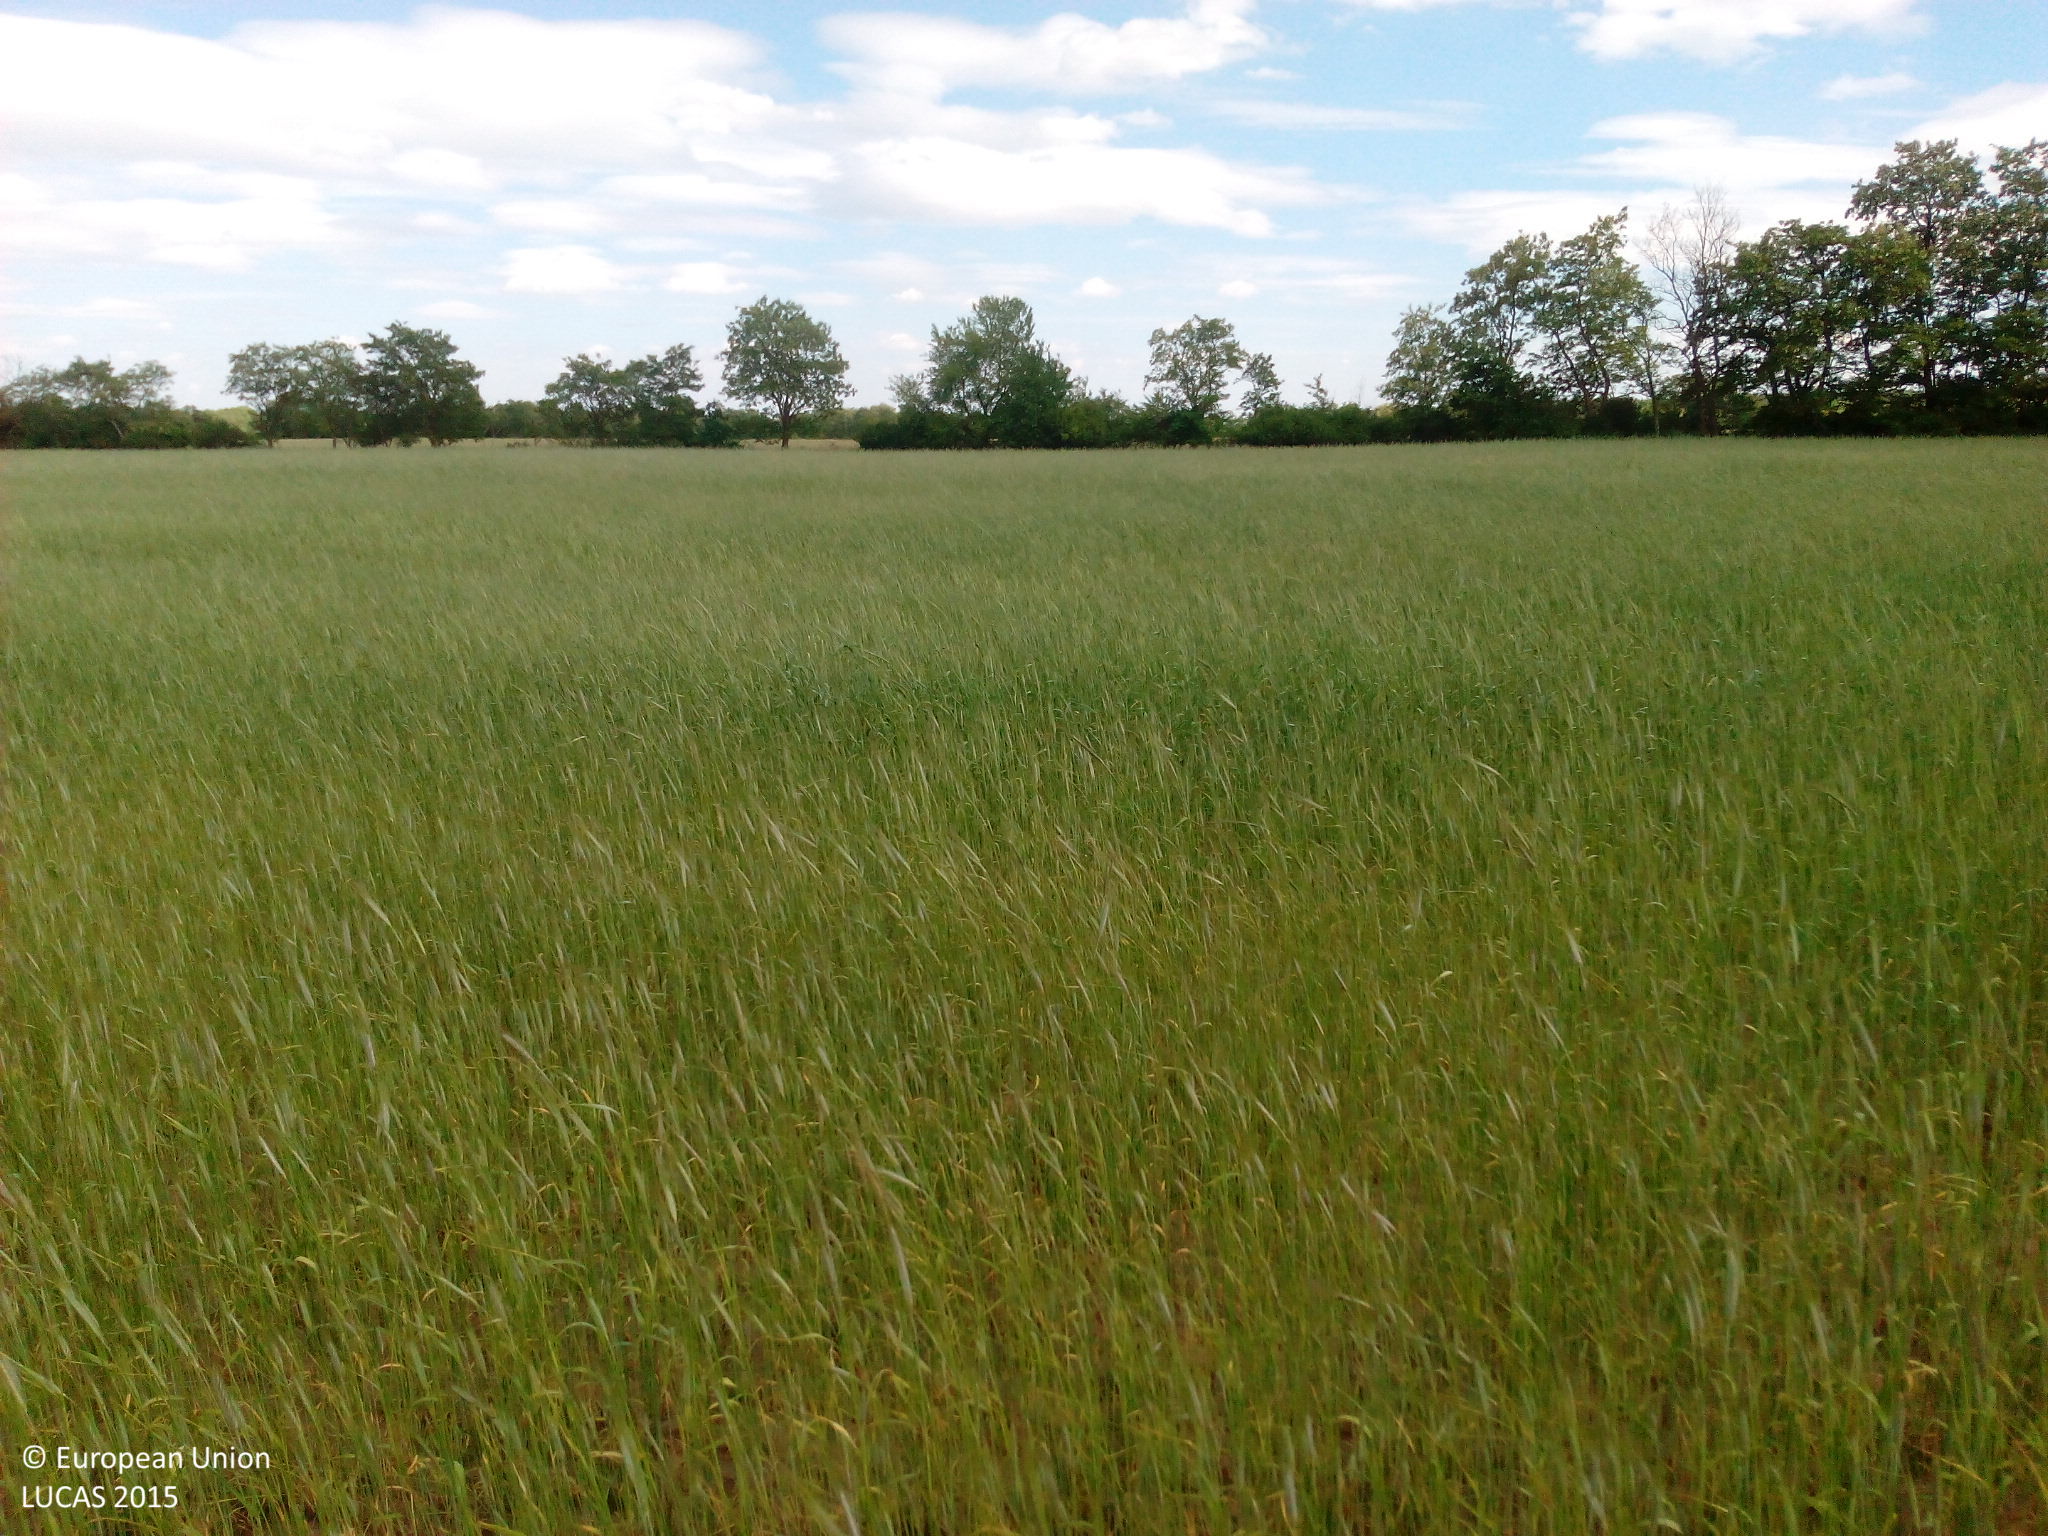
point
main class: Cropland
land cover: Rye
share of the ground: > 75 %
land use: Agriculture (excluding fallow land and kitchen gardens)
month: June
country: DE
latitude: 52.4029
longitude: 12.6013
